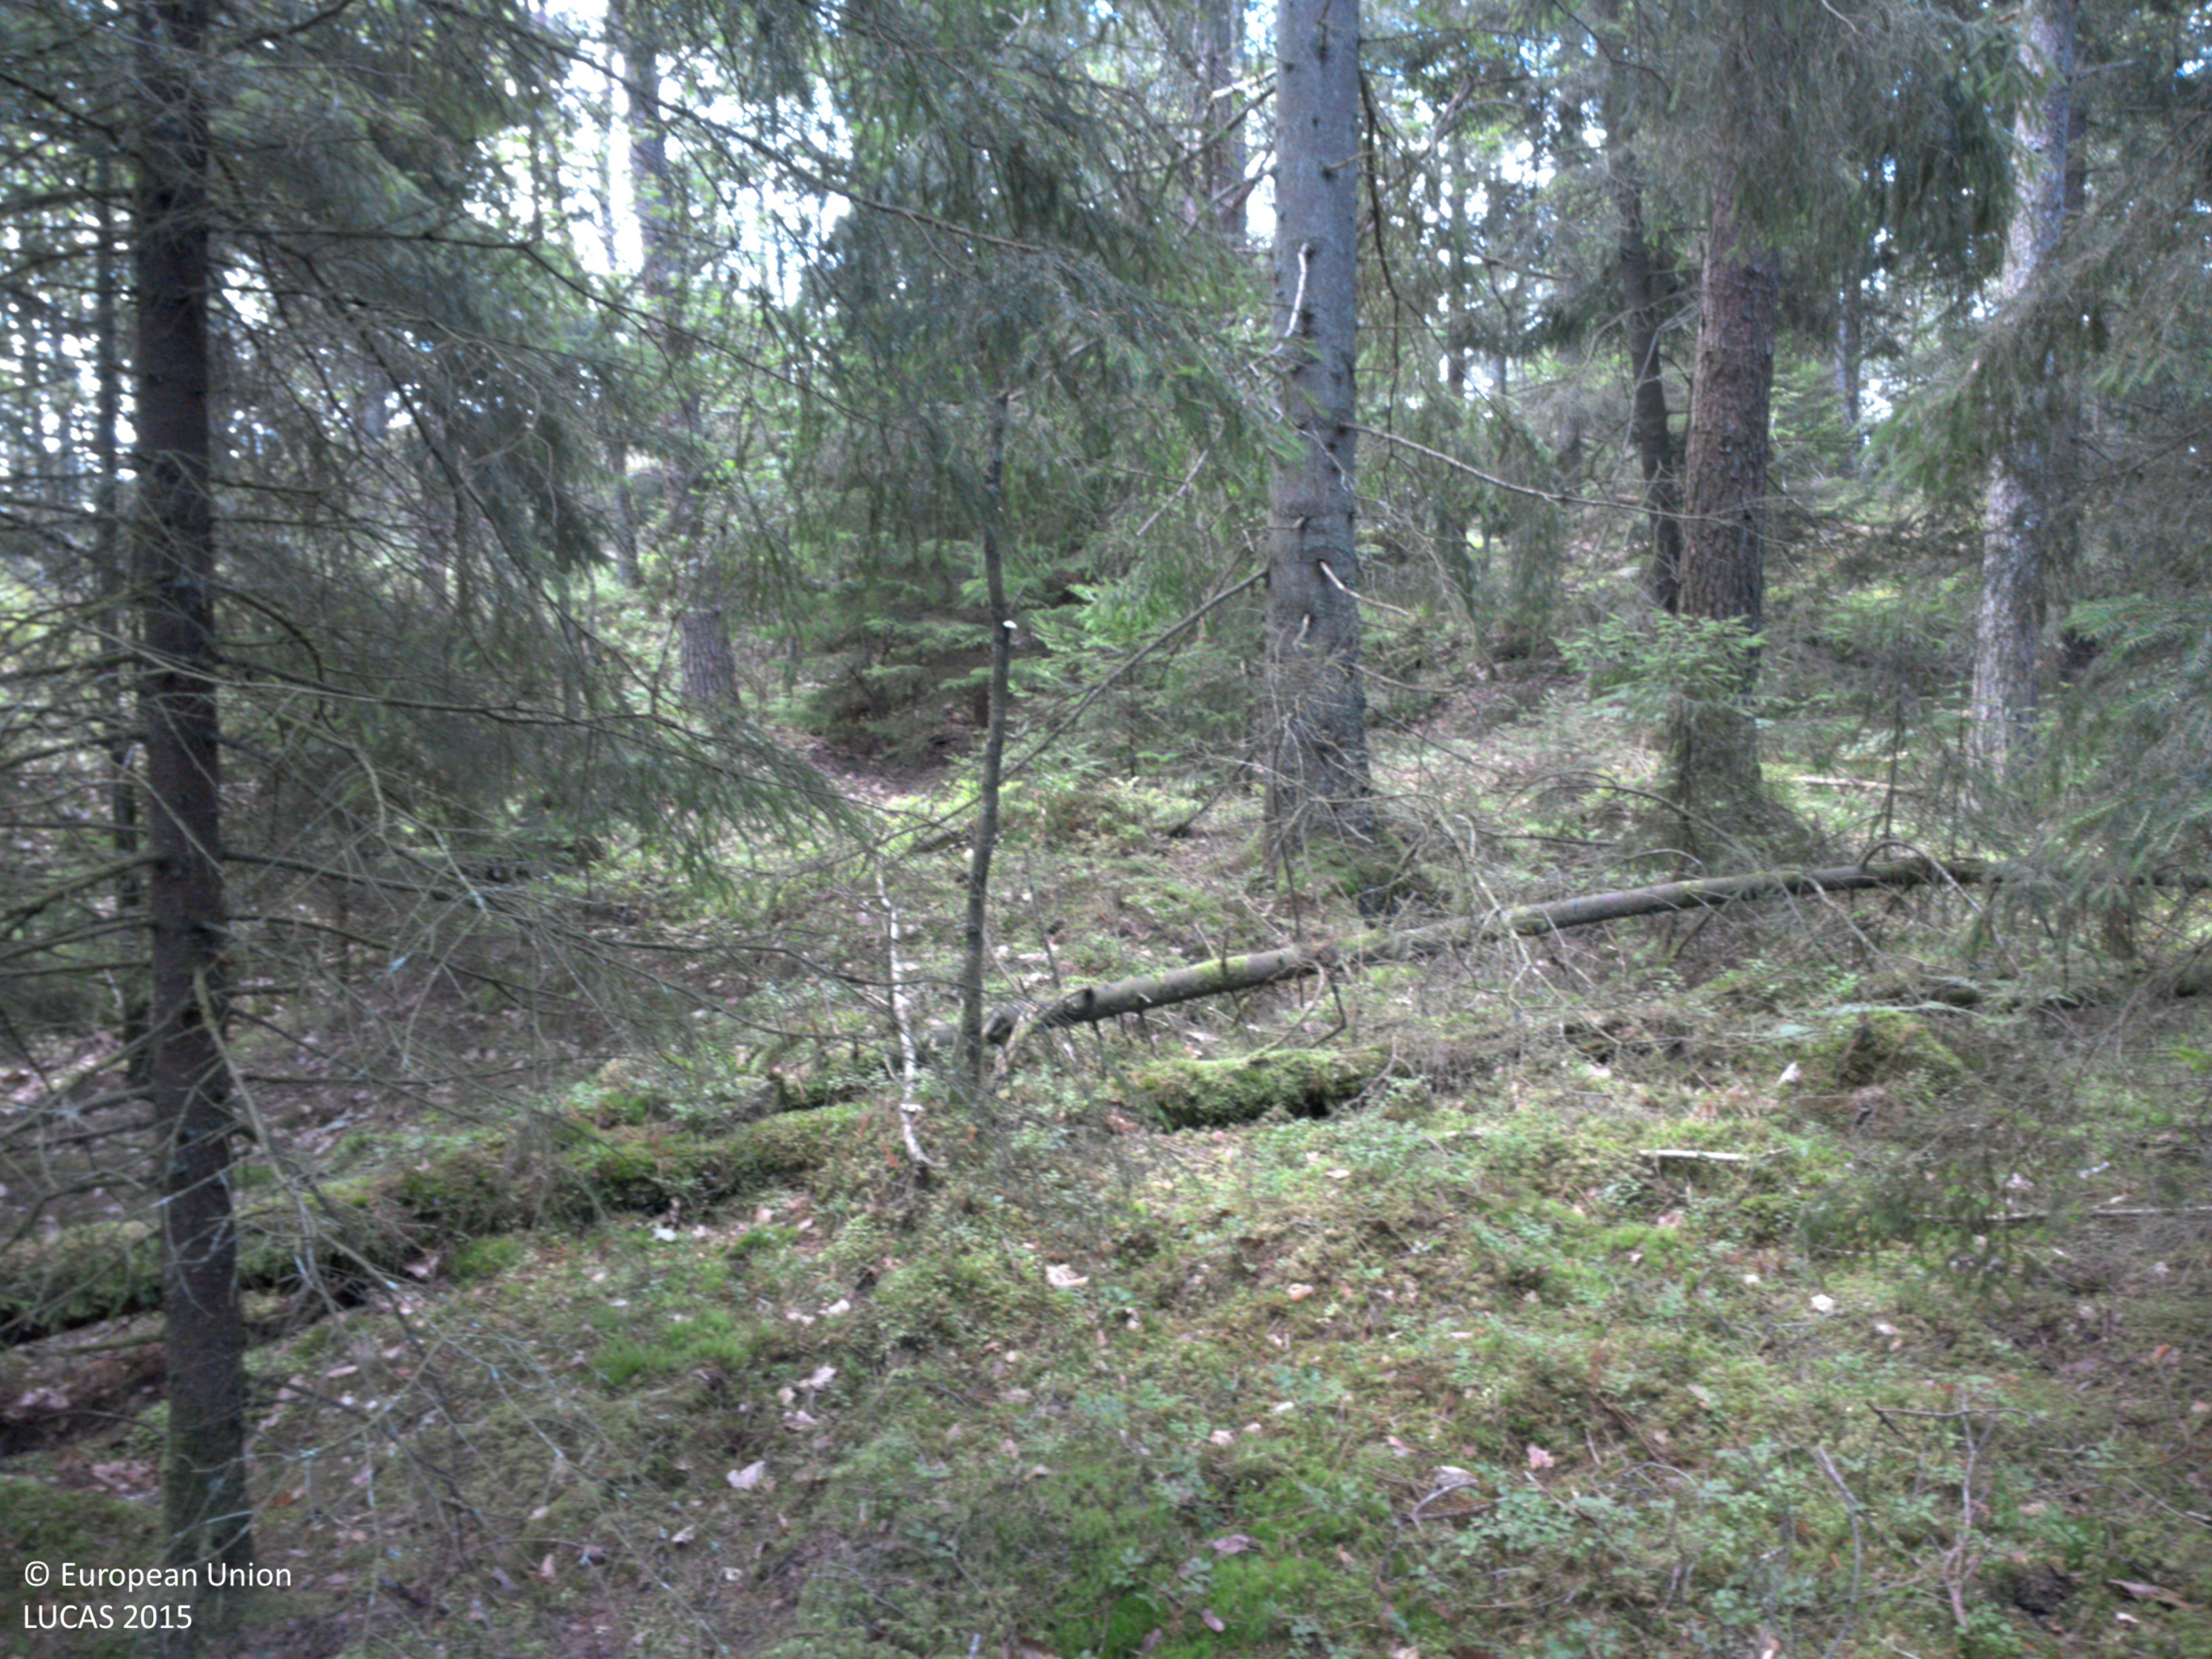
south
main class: Woodland
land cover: Other coniferous woodland
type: boreal forest
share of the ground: 50 - 75 %
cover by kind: coniferous forest trees 50 %, lichens and mosses 35 %, shrubs 15 %
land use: Forestry
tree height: > 5 m
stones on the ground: < 10 %
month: August
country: SE
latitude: 57.9352
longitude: 11.9725
